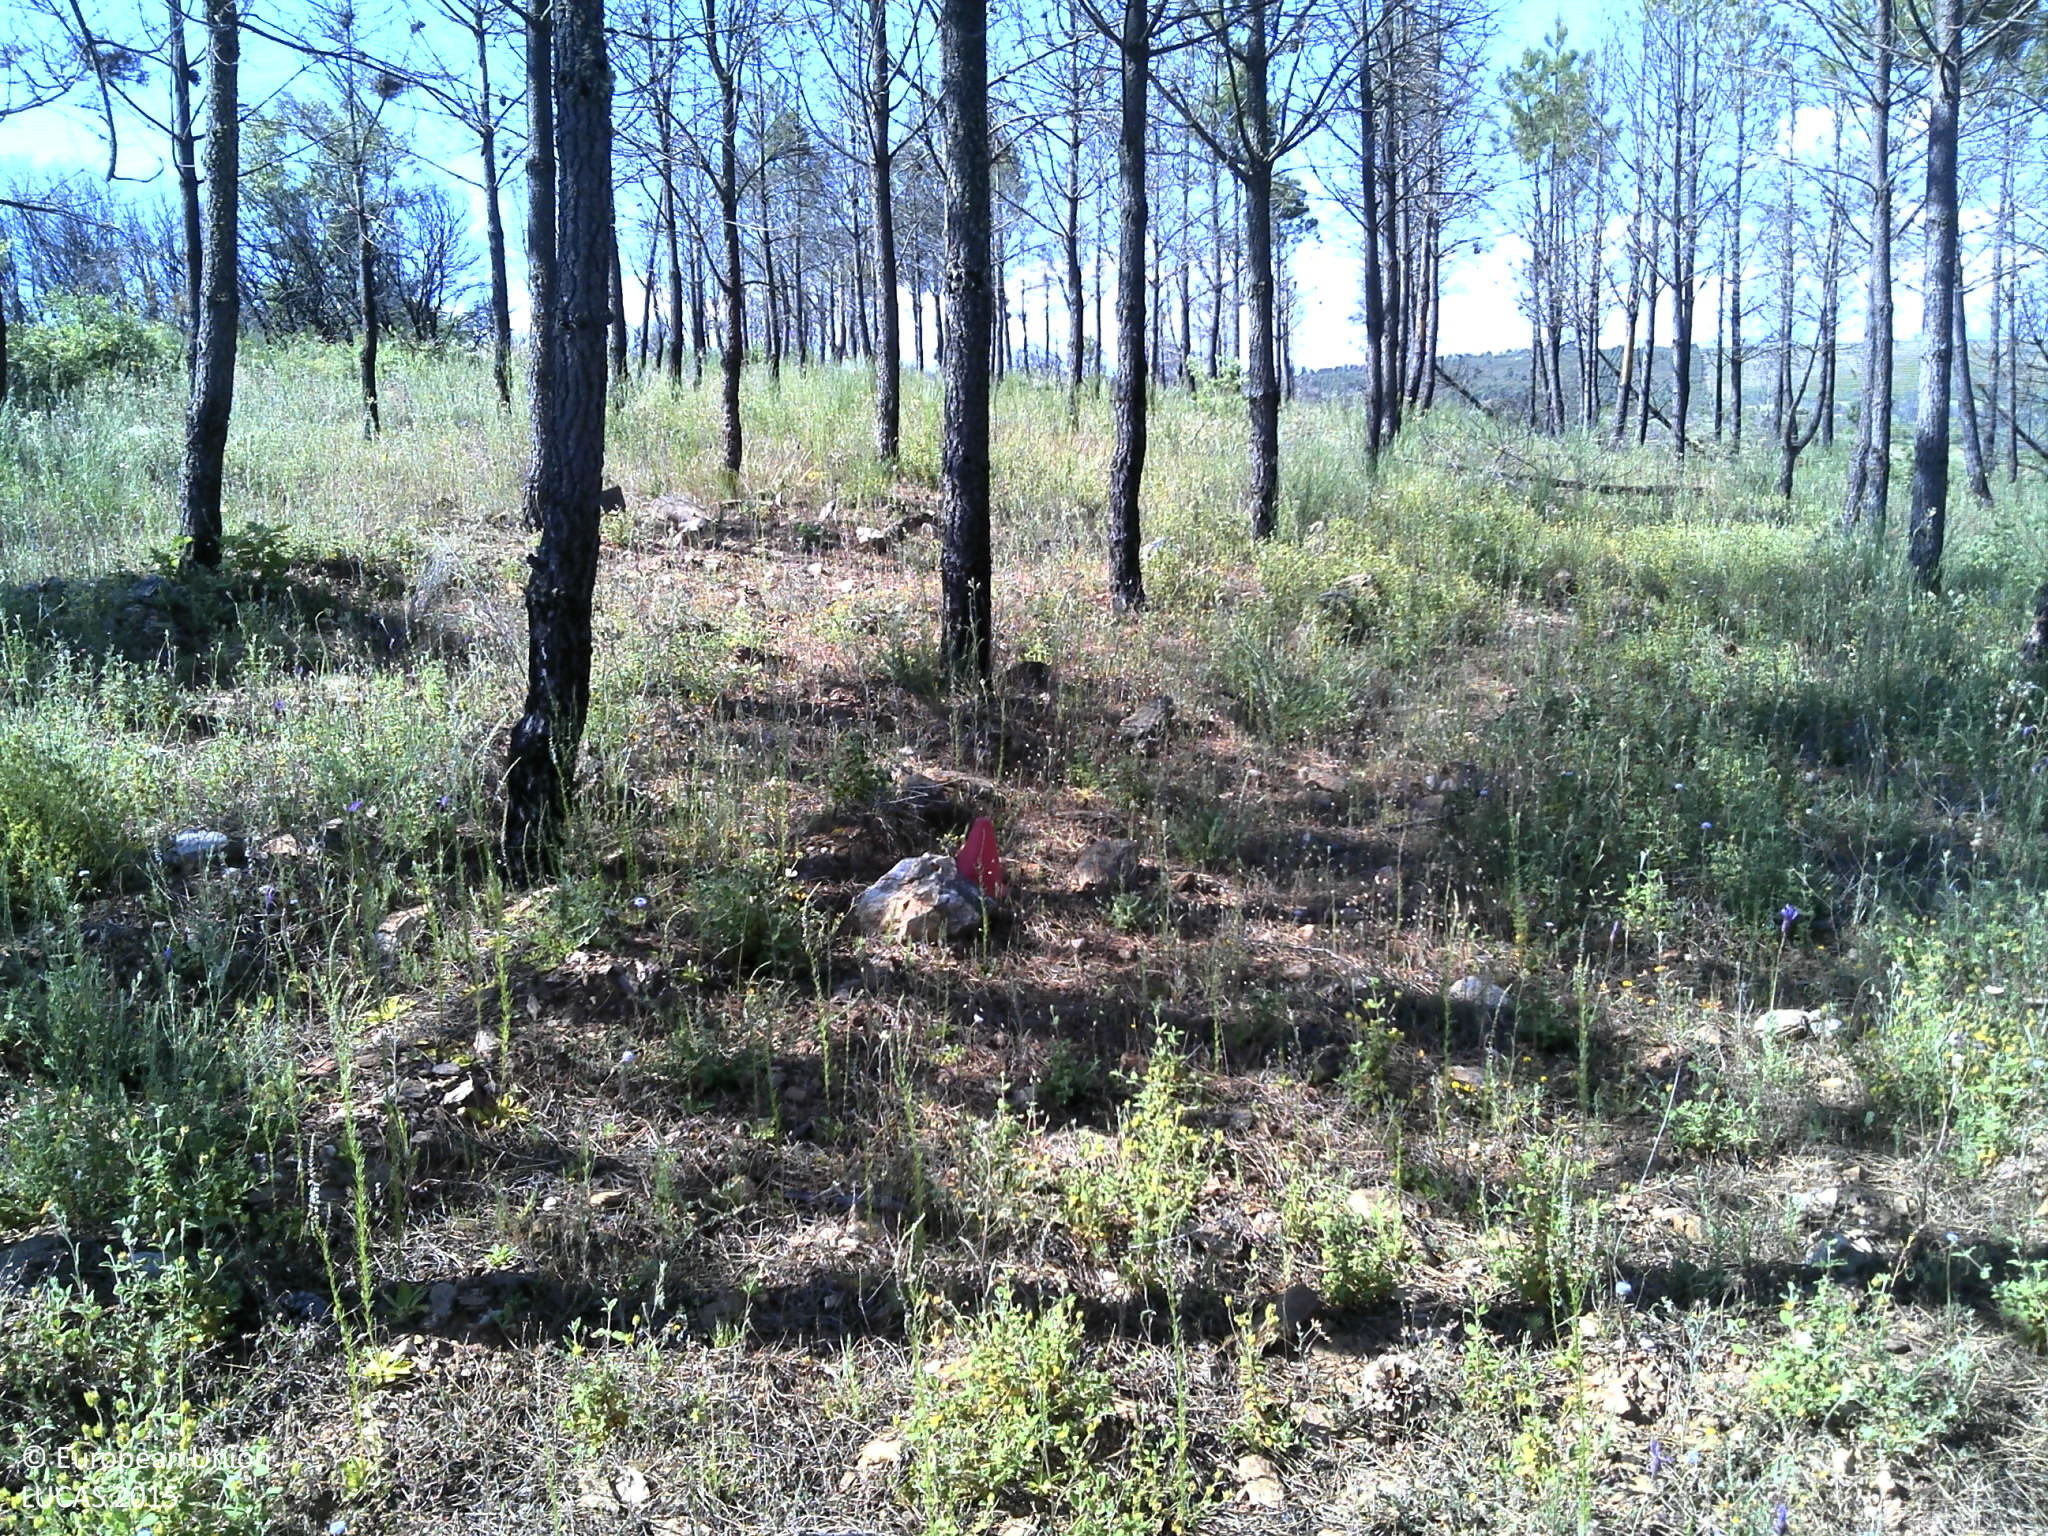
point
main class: Woodland
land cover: Pine dominated coniferous woodland
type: coniferous forest of the mediterranean region
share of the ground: 10 - 25 %
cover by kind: shrubs 50 %, unconsolidated bare surface 30 %, coniferous forest trees 20 %
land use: Forestry
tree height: > 5 m
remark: Burnt area
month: May
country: PT
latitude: 41.6505
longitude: -6.3227
